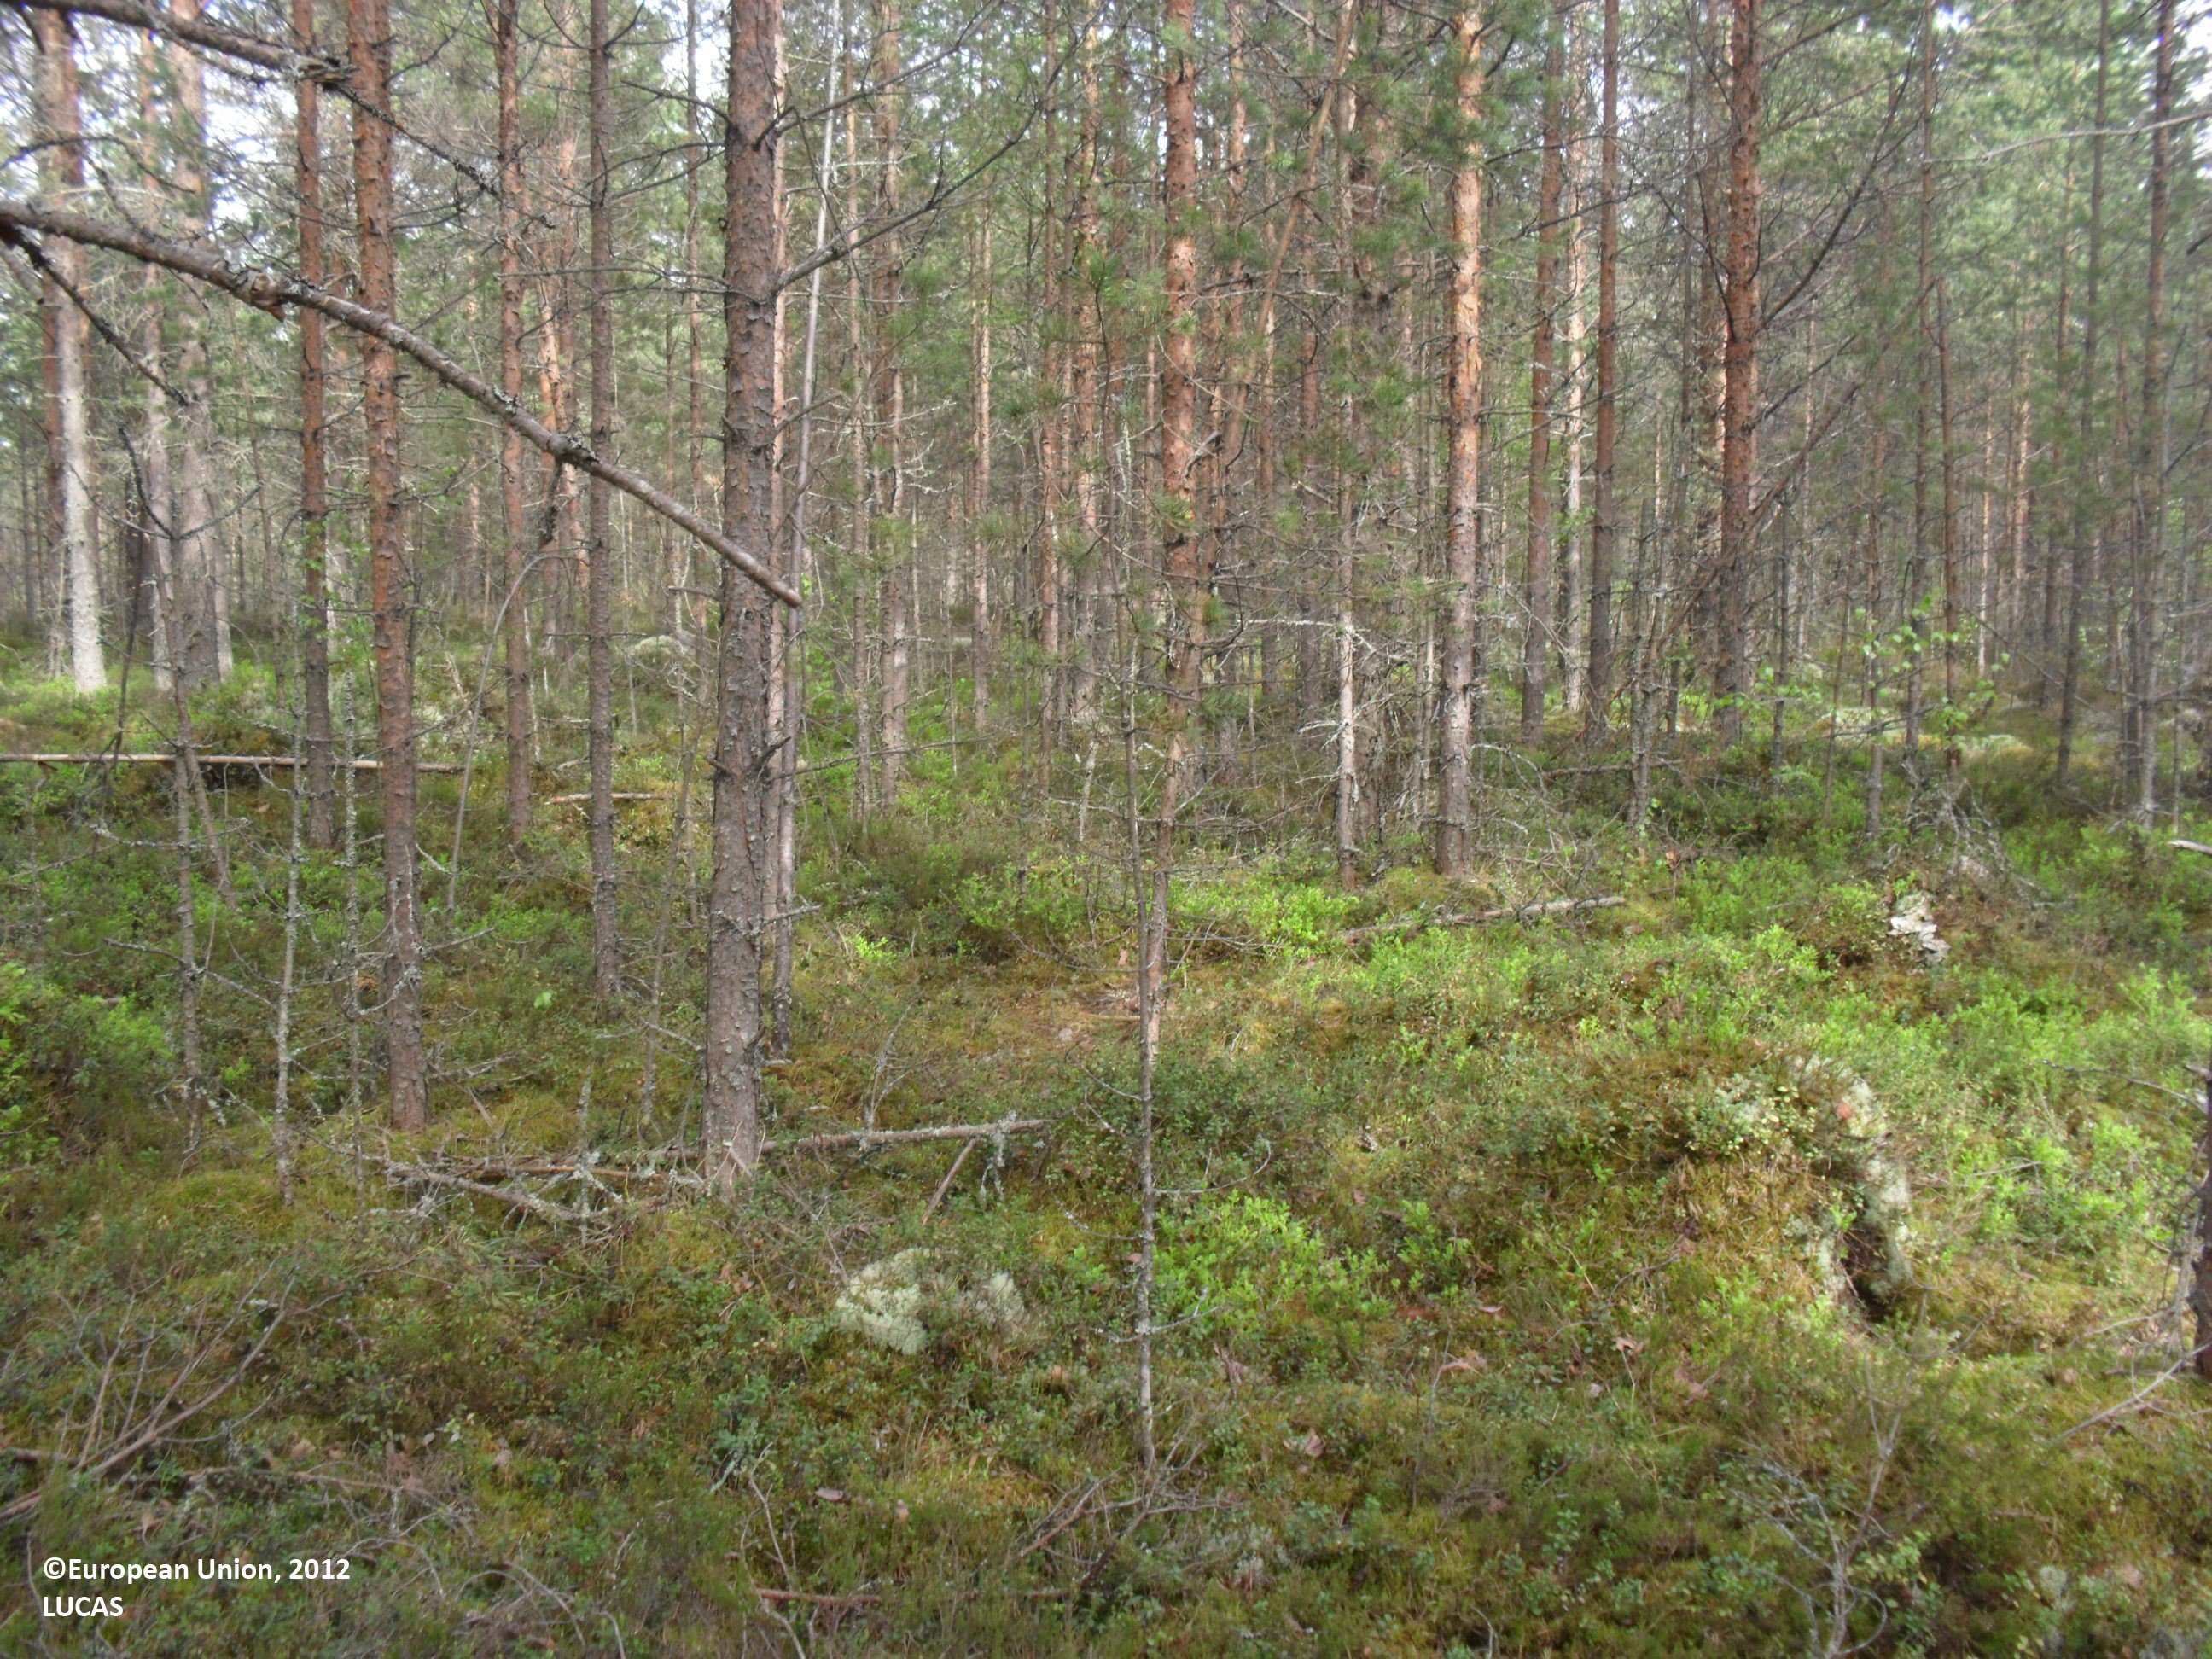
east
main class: Woodland
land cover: Pine dominated coniferous woodland
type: boreal forest
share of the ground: 50 - 75 %
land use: Forestry
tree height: > 5 m
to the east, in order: Pine dominated coniferous woodland; Lichens and moss; Pine dominated coniferous woodland; Ditches and canals; Pine dominated coniferous woodland; Ditches and canals; Pine dominated coniferous woodland
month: June
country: FI
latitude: 62.7894
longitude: 23.2970
